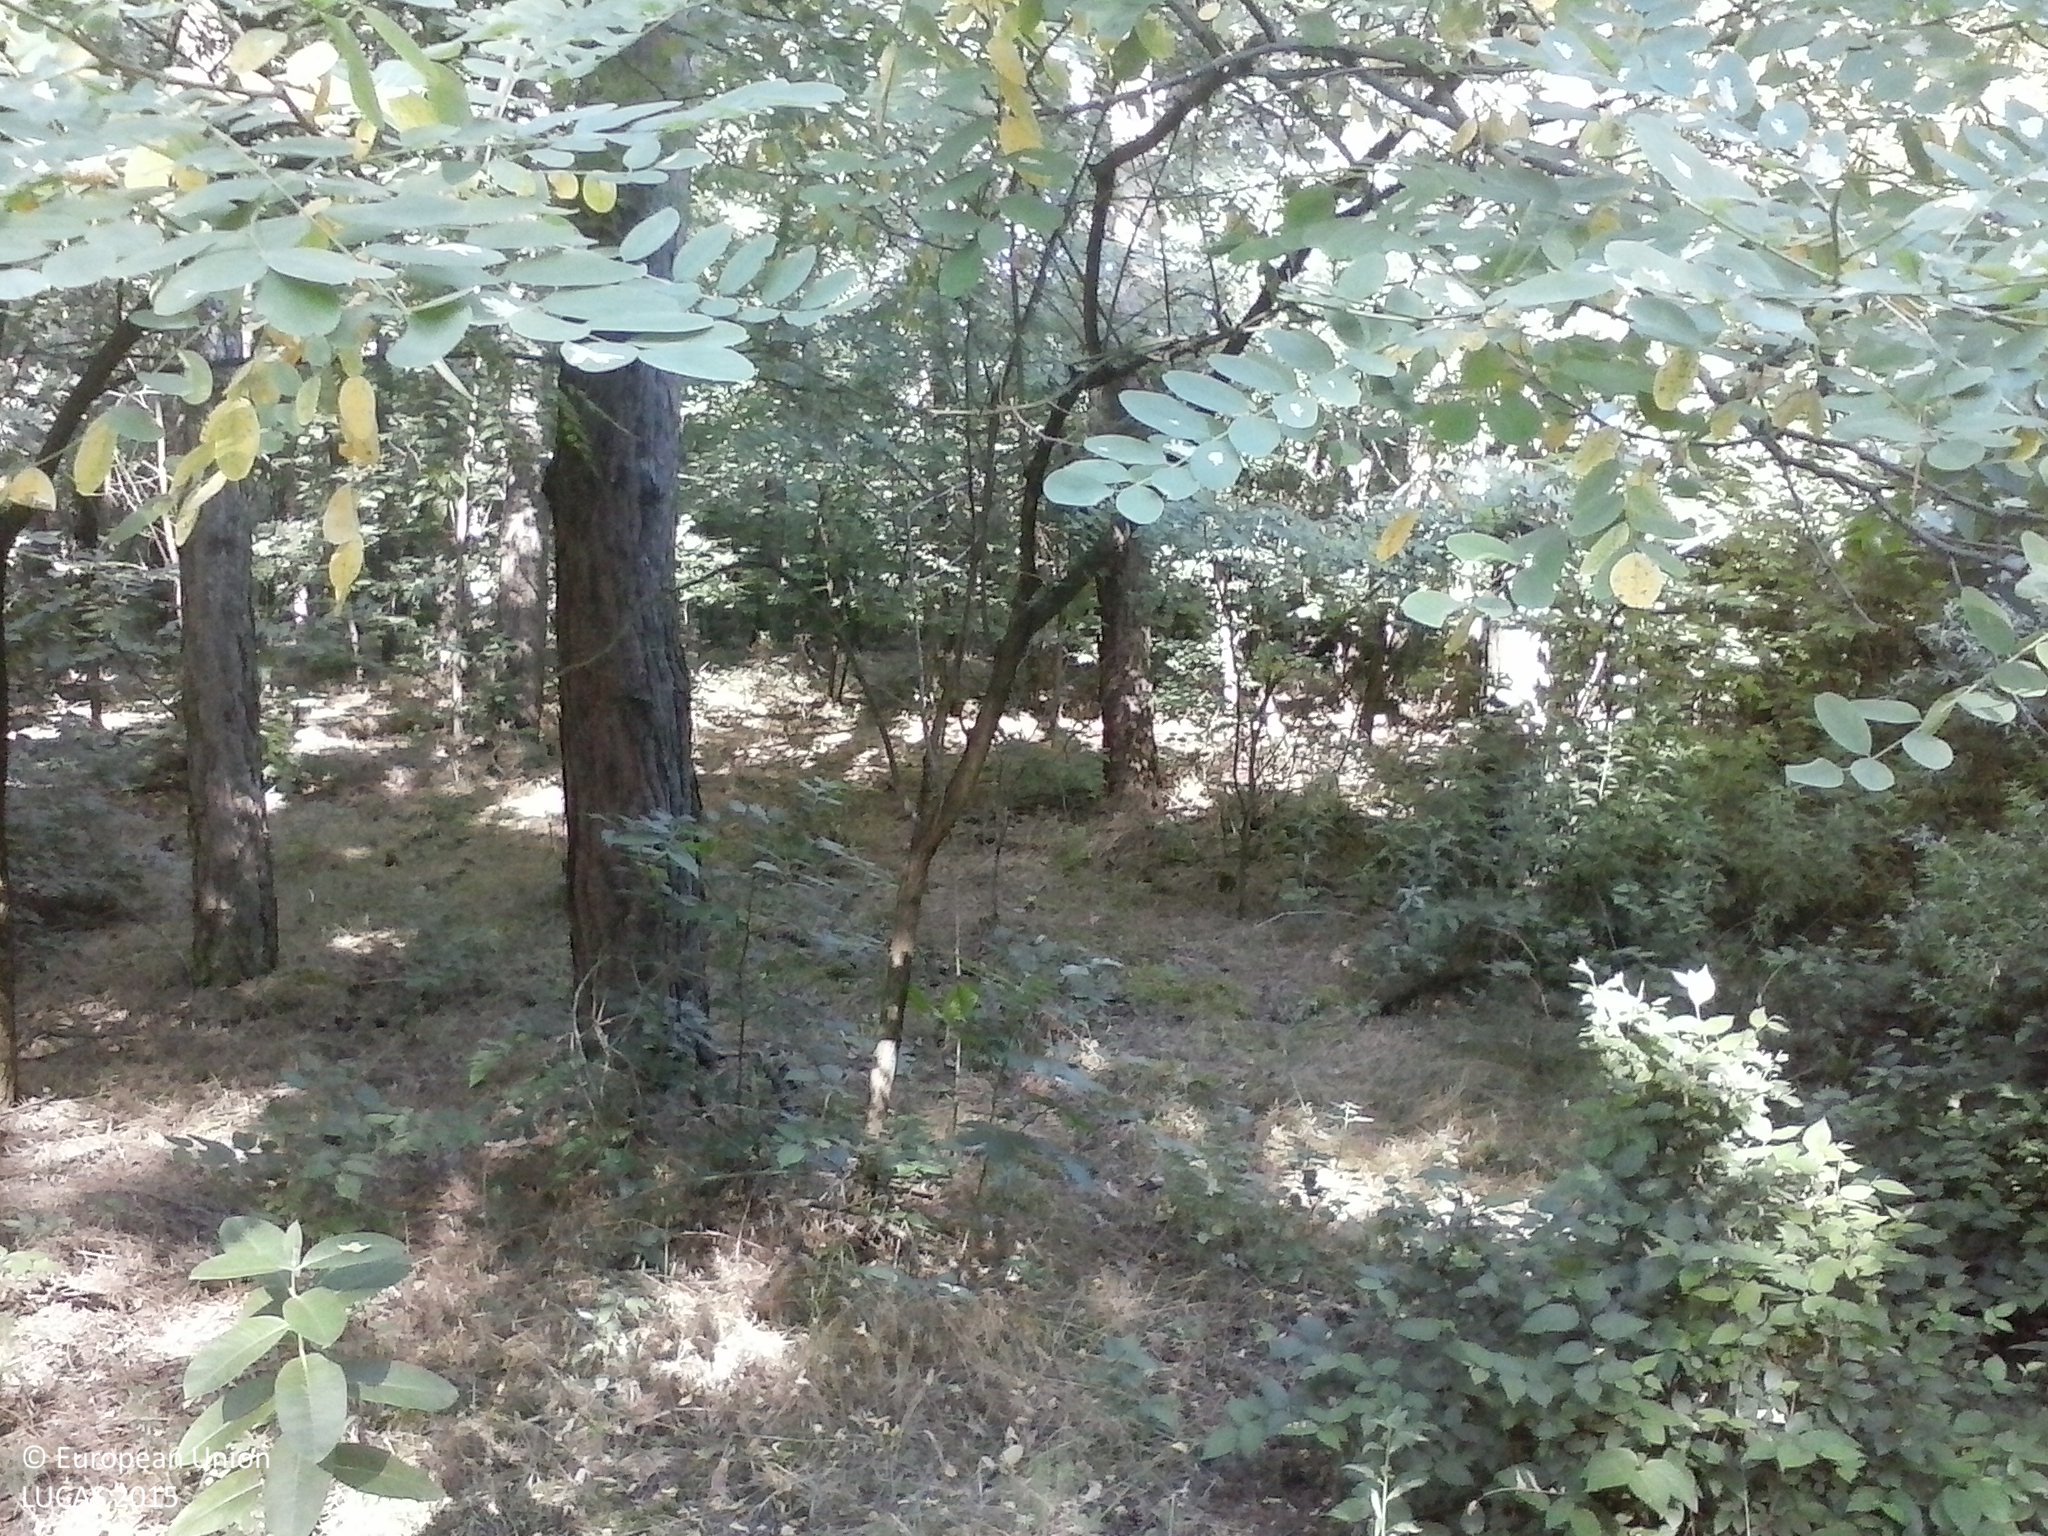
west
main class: Woodland
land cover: Pine dominated coniferous woodland
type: hemiboreal forest and nemoral coniferous forest and mixed broadleaved-coniferous forest
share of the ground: > 75 %
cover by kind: coniferous forest trees 70 %, broadleaved forest trees 20 %, shrubs 5 %, herbaceous plants 5 %
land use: Forestry
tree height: > 5 m
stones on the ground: < 10 %
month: July
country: HU
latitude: 46.3114
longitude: 19.6662
